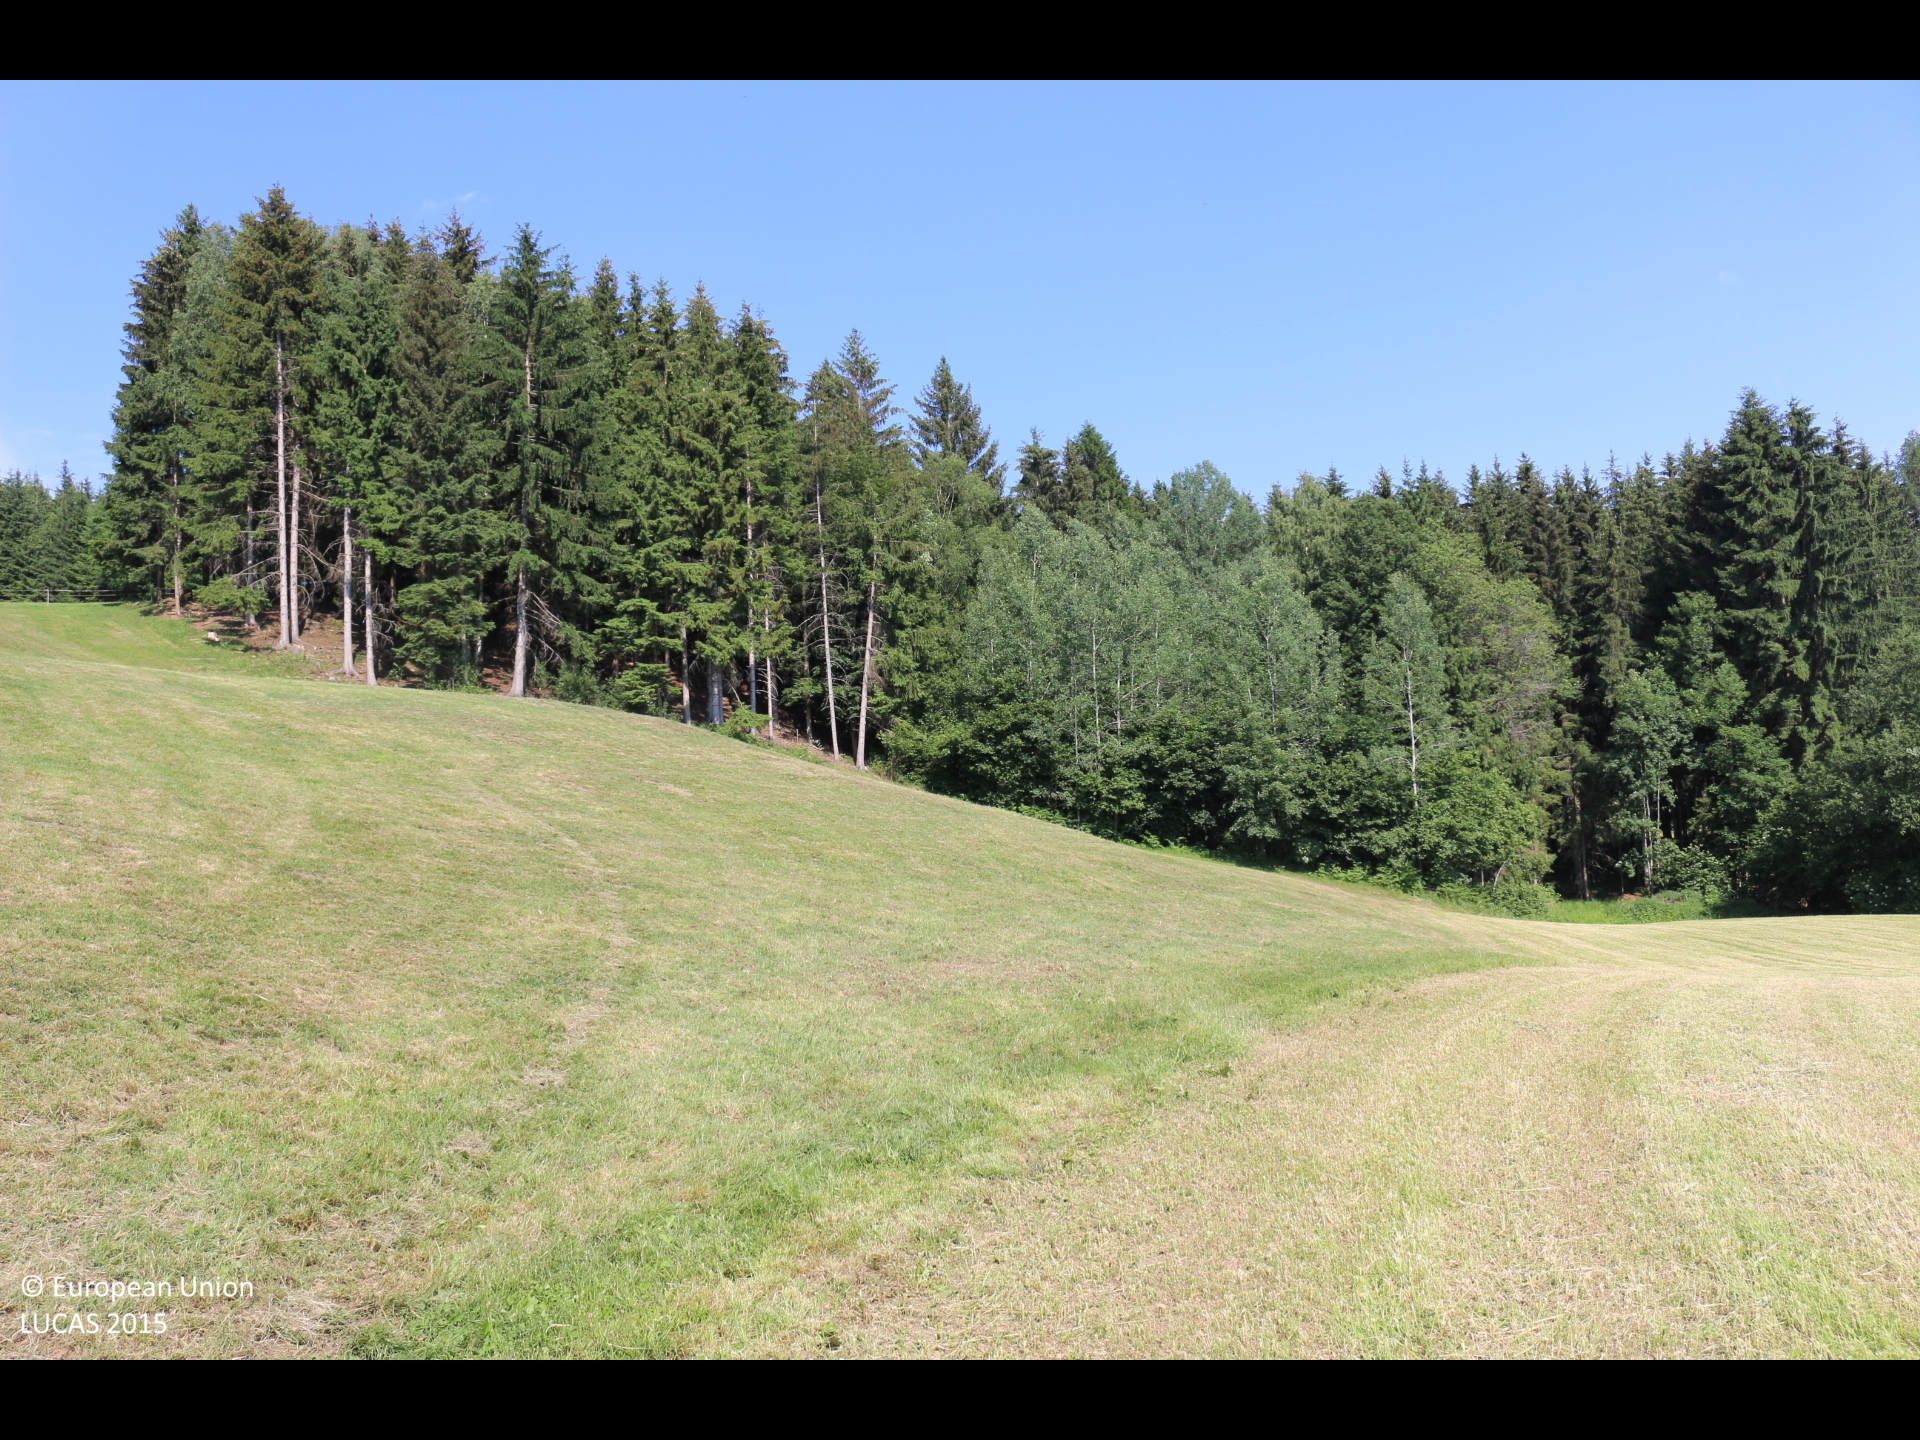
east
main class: Grassland
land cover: Grassland without tree/shrub cover
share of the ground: > 75 %
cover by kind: herbaceous plants 100 %
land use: Agriculture (excluding fallow land and kitchen gardens)
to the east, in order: Grassland without tree/shrub cover; Spruce dominated mixed woodland; Rivers and streams; Spruce dominated mixed woodland
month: June
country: AT
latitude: 46.6538
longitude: 14.0351
